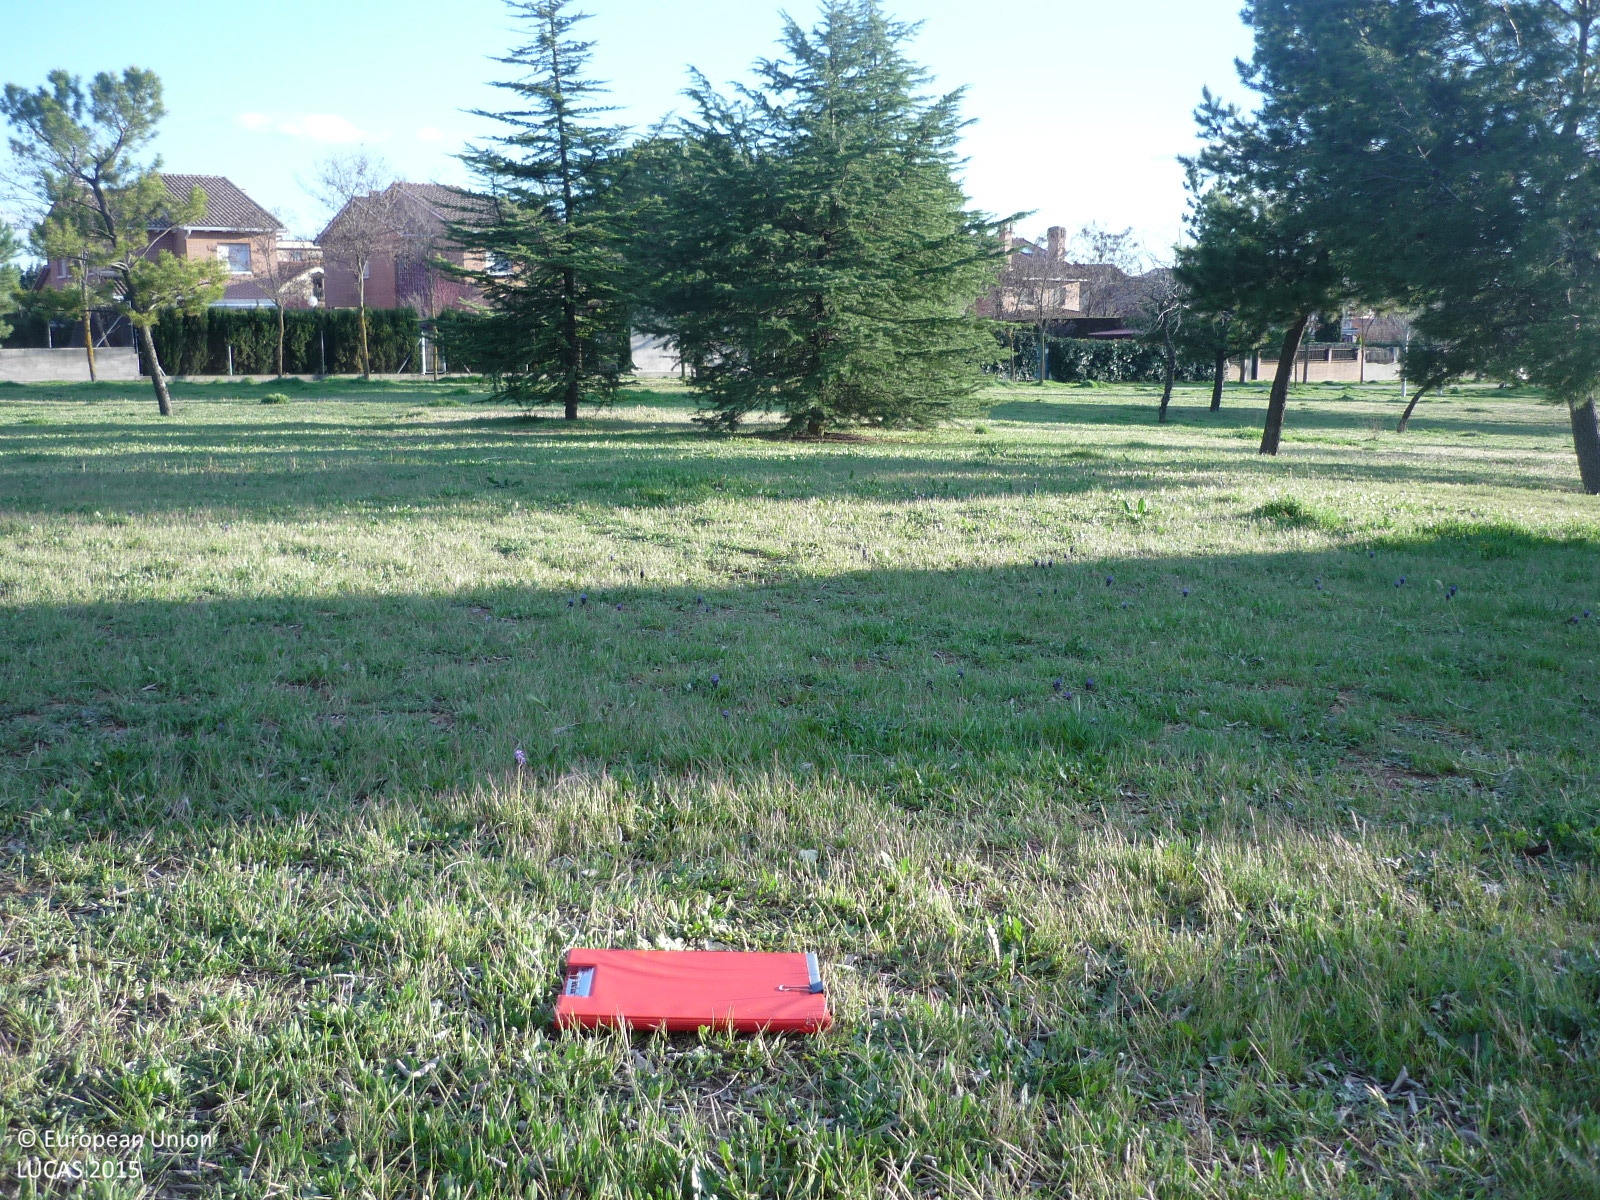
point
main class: Woodland
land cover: Other mixed woodland
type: coniferous forest of the mediterranean region
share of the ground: 25 - 50 %
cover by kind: herbaceous plants 70 %, coniferous forest trees 20 %, broadleaved forest trees 10 %
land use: Residential
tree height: < 5 m
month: March
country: ES
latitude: 40.4464
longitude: -3.3685
